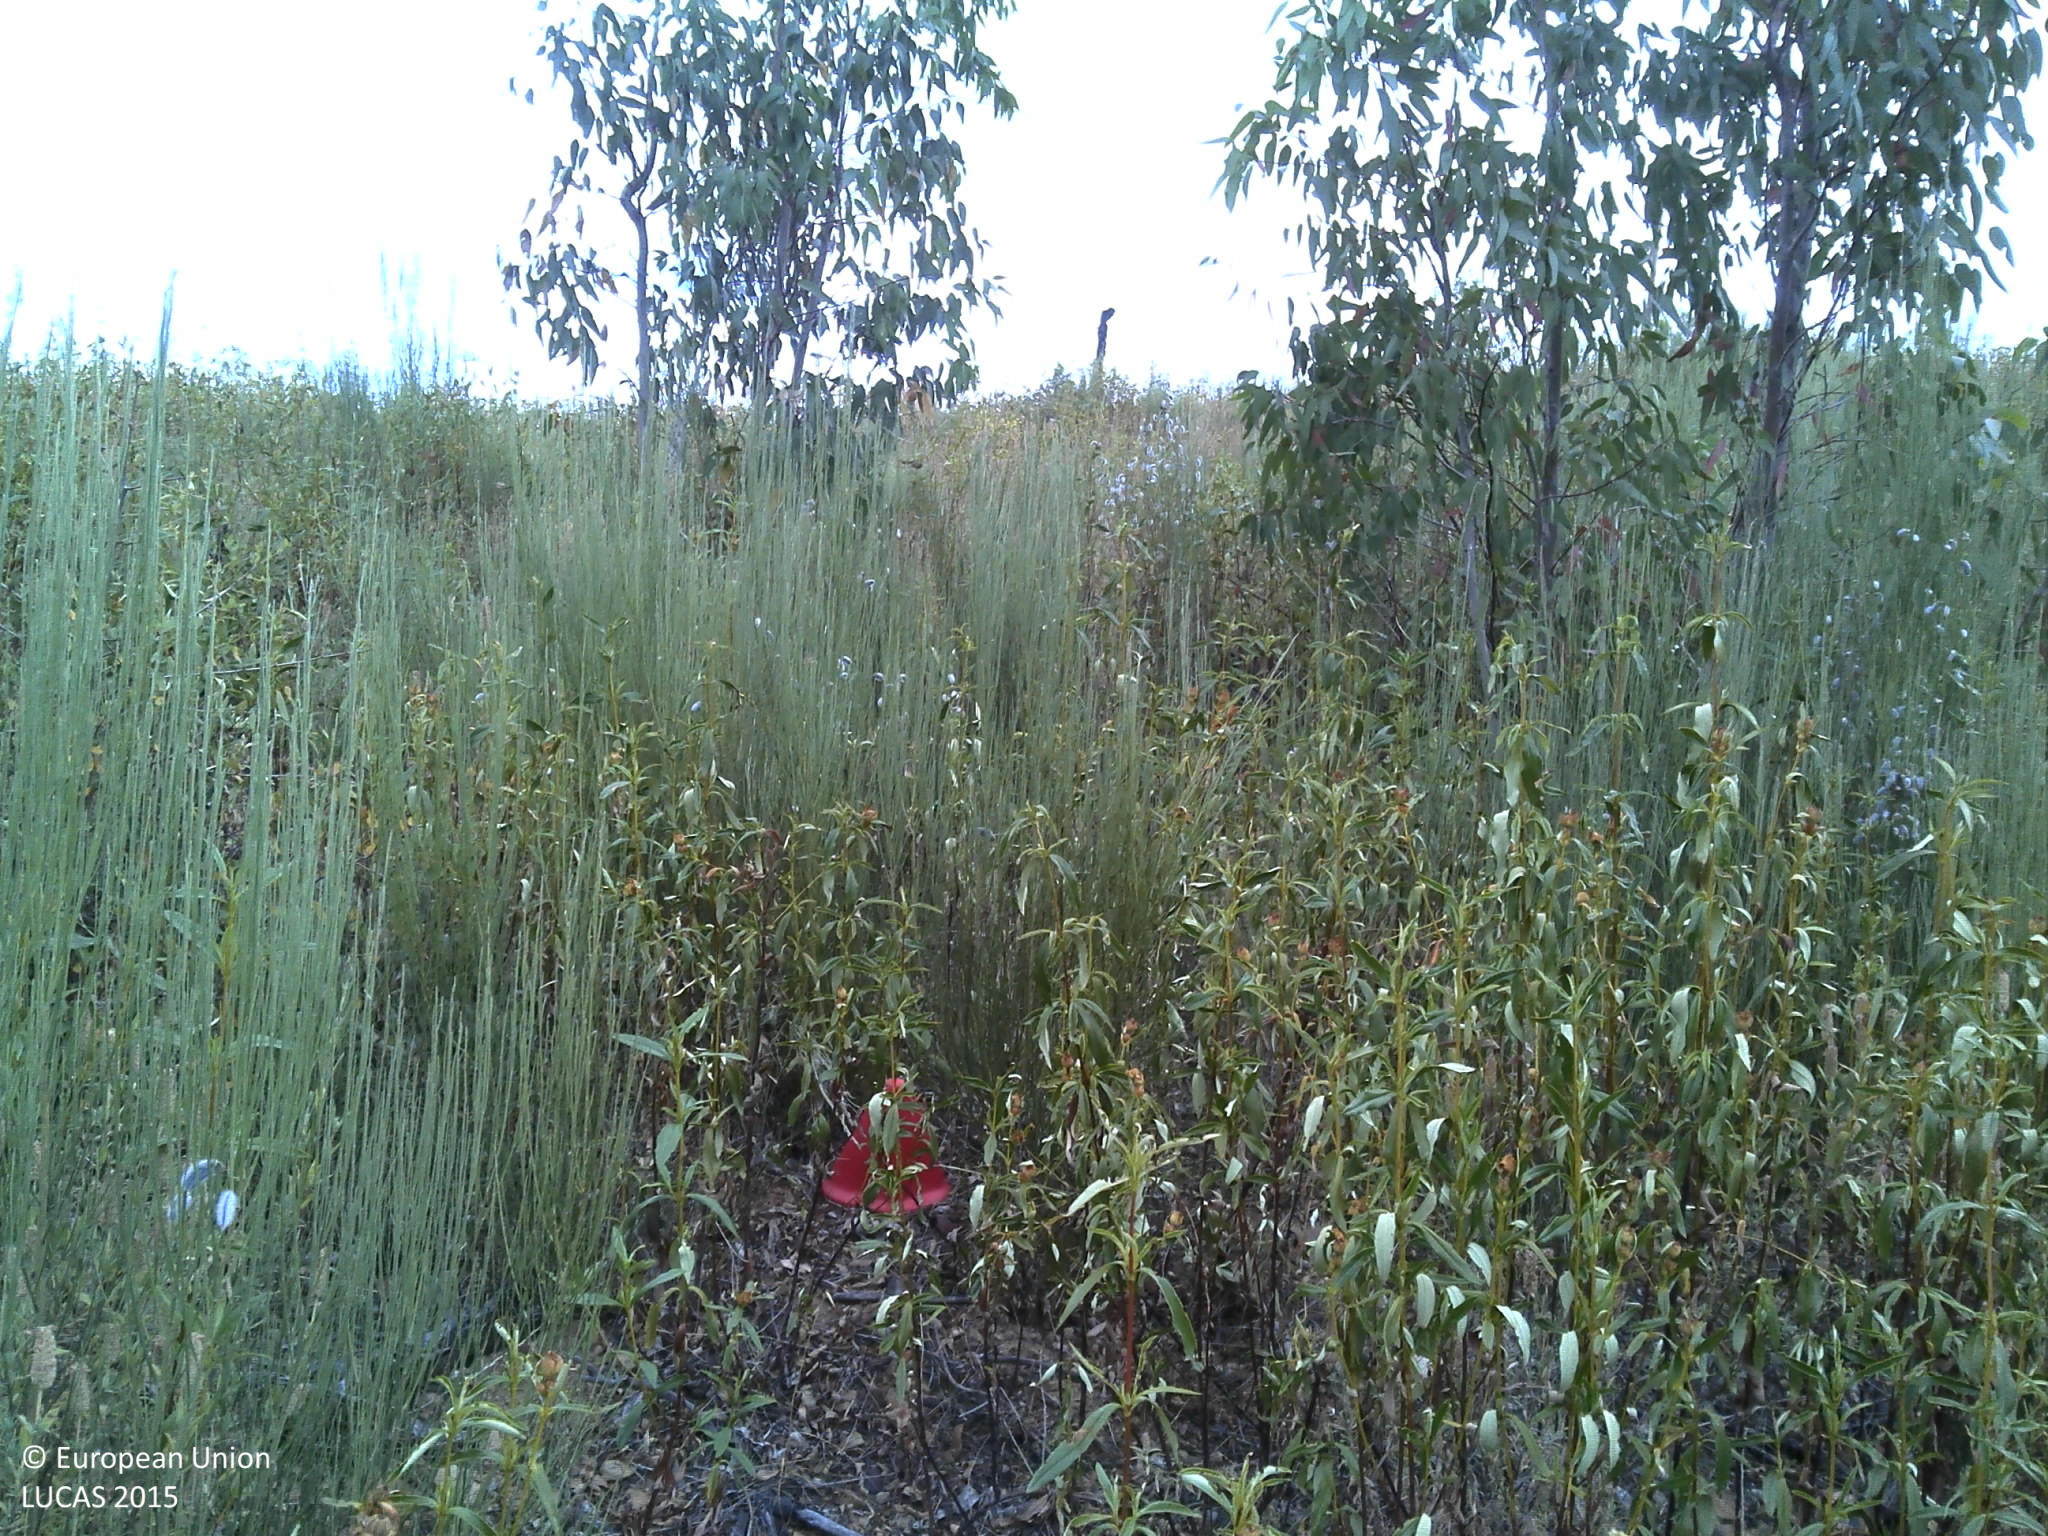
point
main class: Woodland
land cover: Broadleaved woodland
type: exotic forest
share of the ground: 10 - 25 %
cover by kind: shrubs 45 %, broadleaved forest trees 25 %, unconsolidated bare surface 20 %, herbaceous plants 10 %
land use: Forestry
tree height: < 5 m
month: June
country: PT
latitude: 37.3026
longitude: -7.8495
